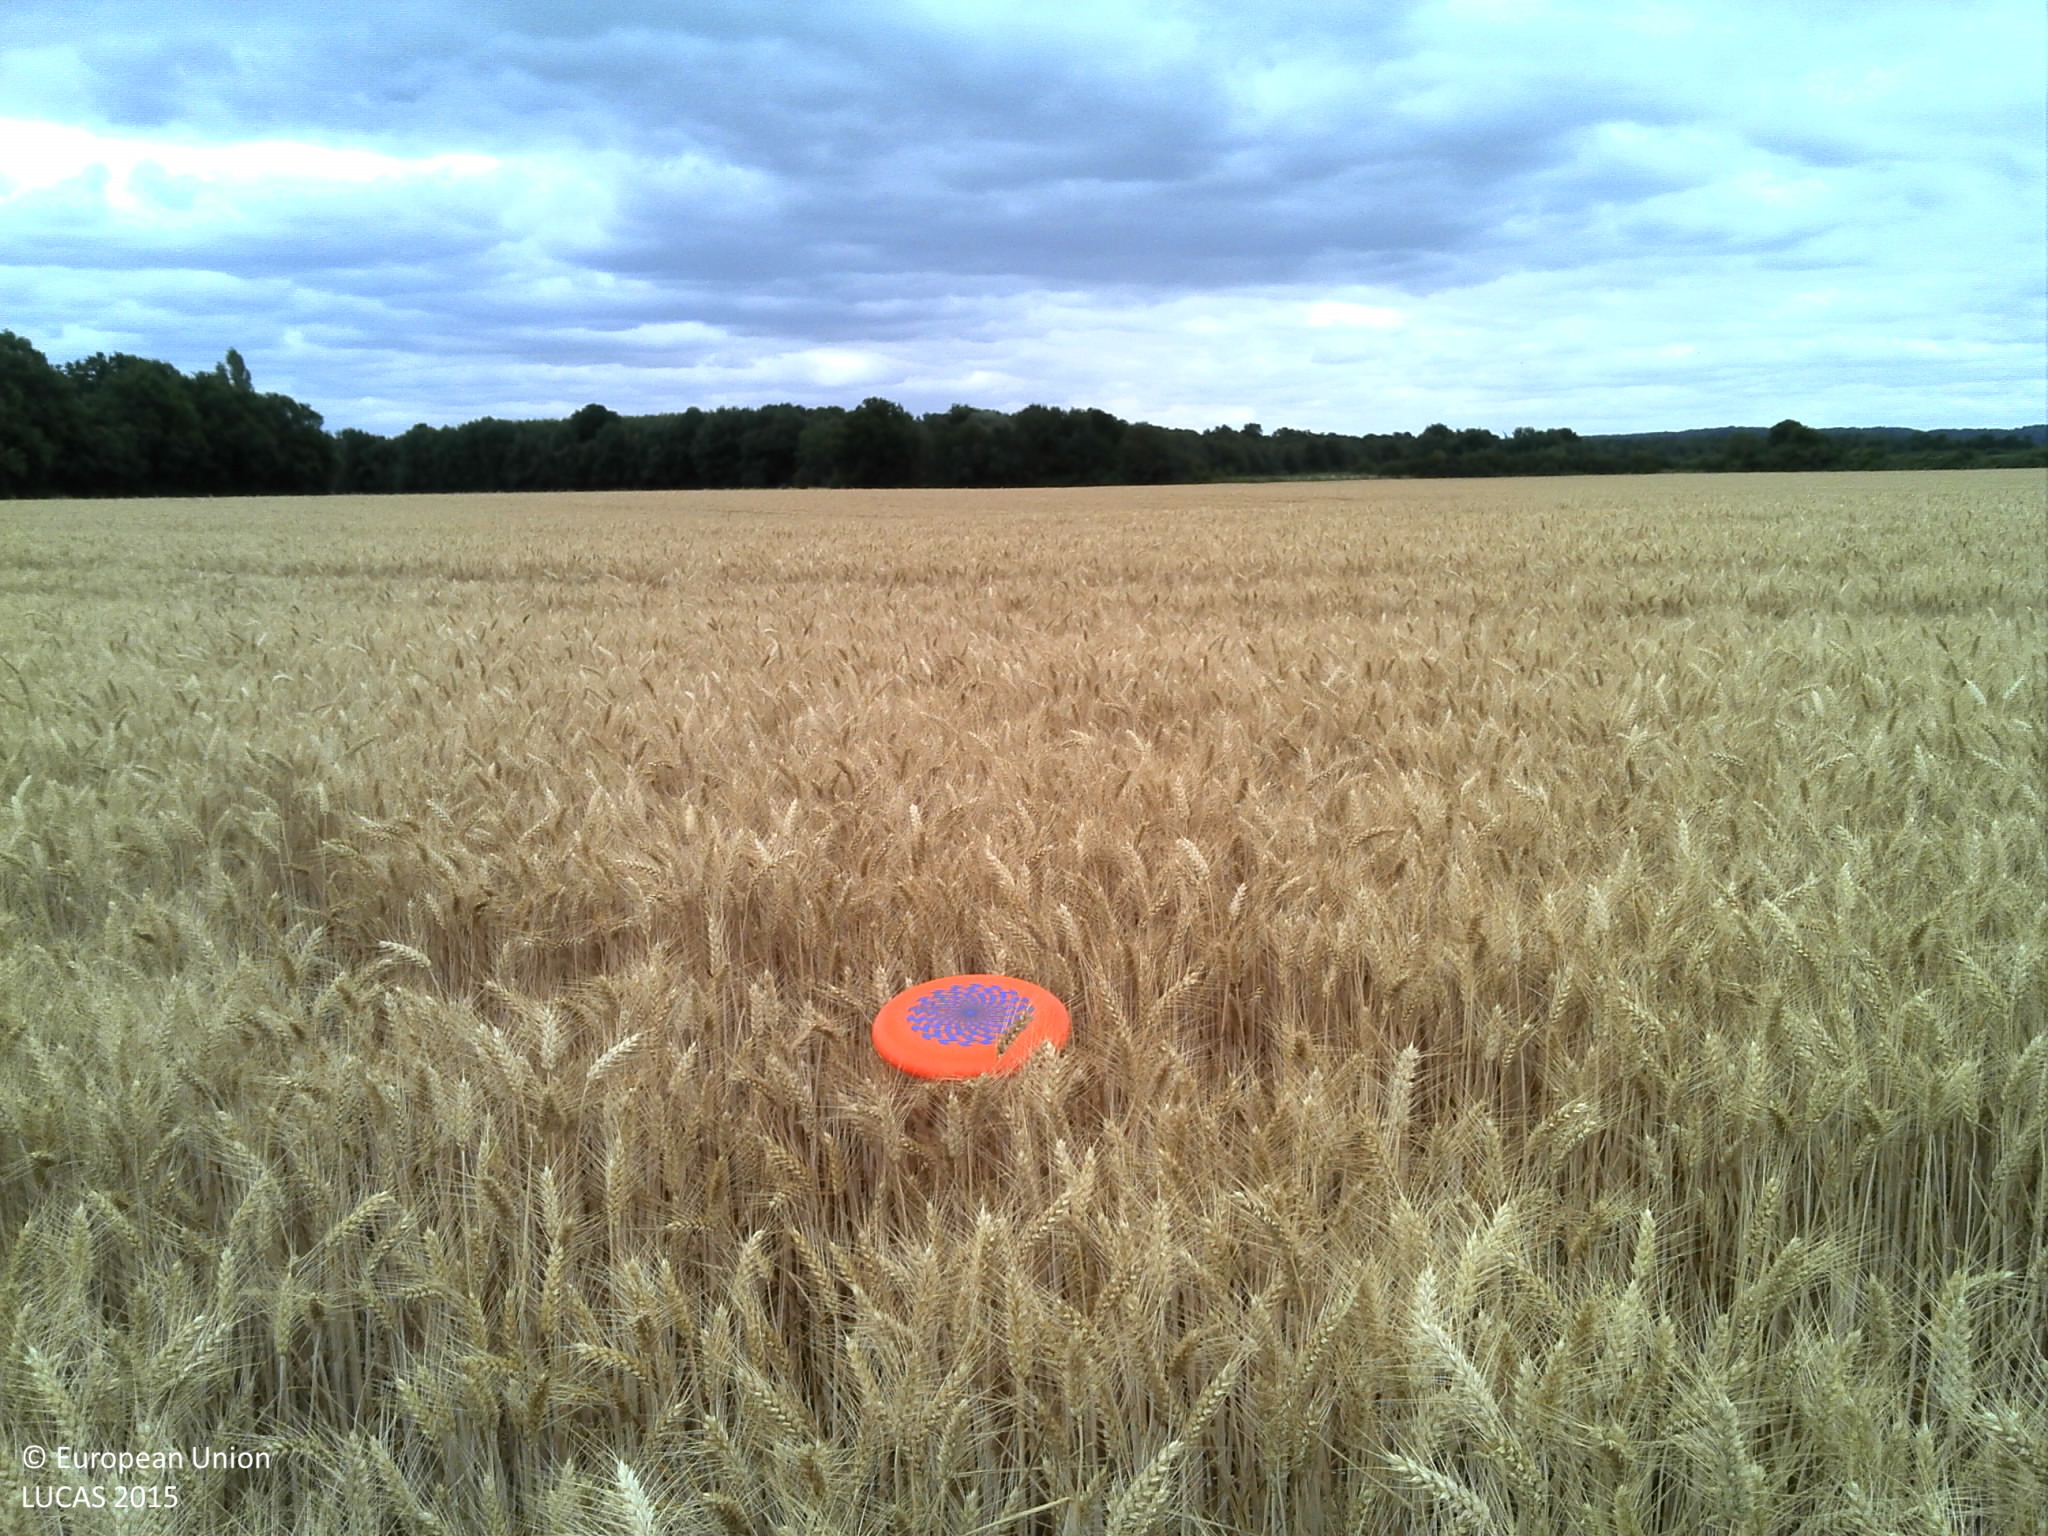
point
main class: Cropland
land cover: Durum wheat
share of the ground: > 75 %
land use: Agriculture (excluding fallow land and kitchen gardens)
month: July
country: FR
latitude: 48.5442
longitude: 2.4714
